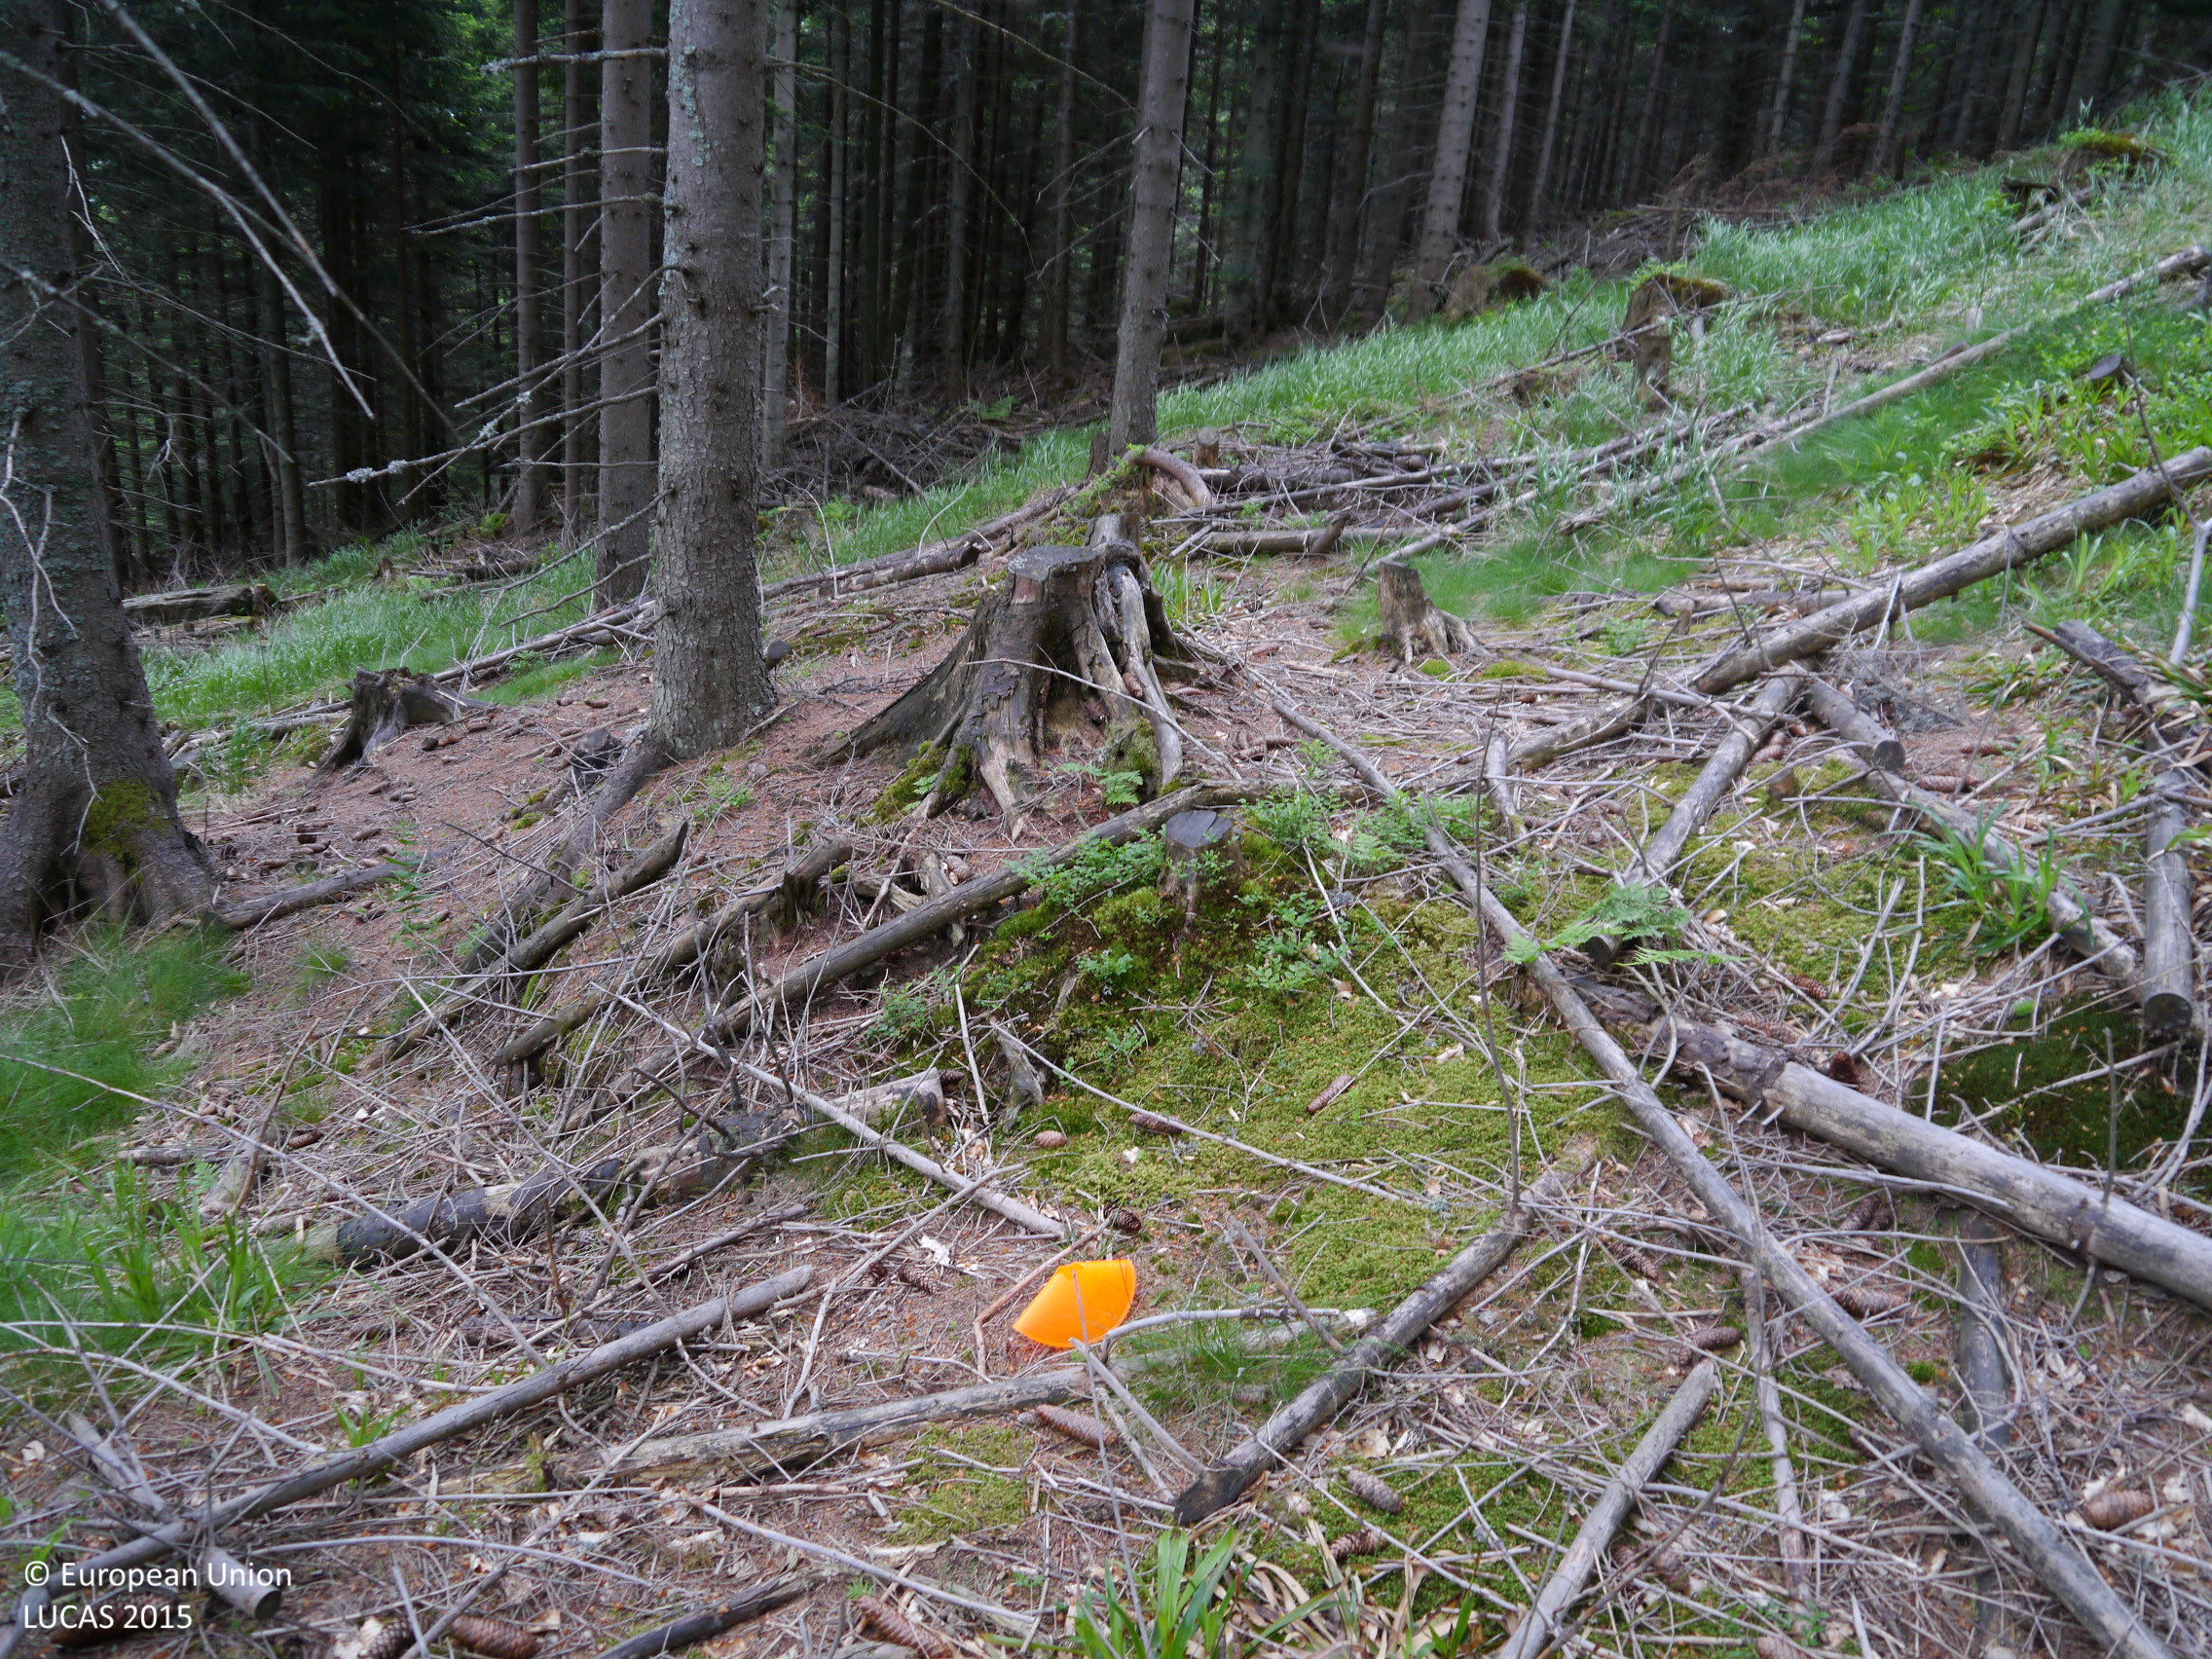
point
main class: Woodland
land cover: Spruce dominated coniferous woodland
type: alpine coniferous forest
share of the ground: > 75 %
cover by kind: coniferous forest trees 100 %
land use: Forestry
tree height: > 5 m
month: June
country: AT
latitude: 46.7533
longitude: 15.0910
